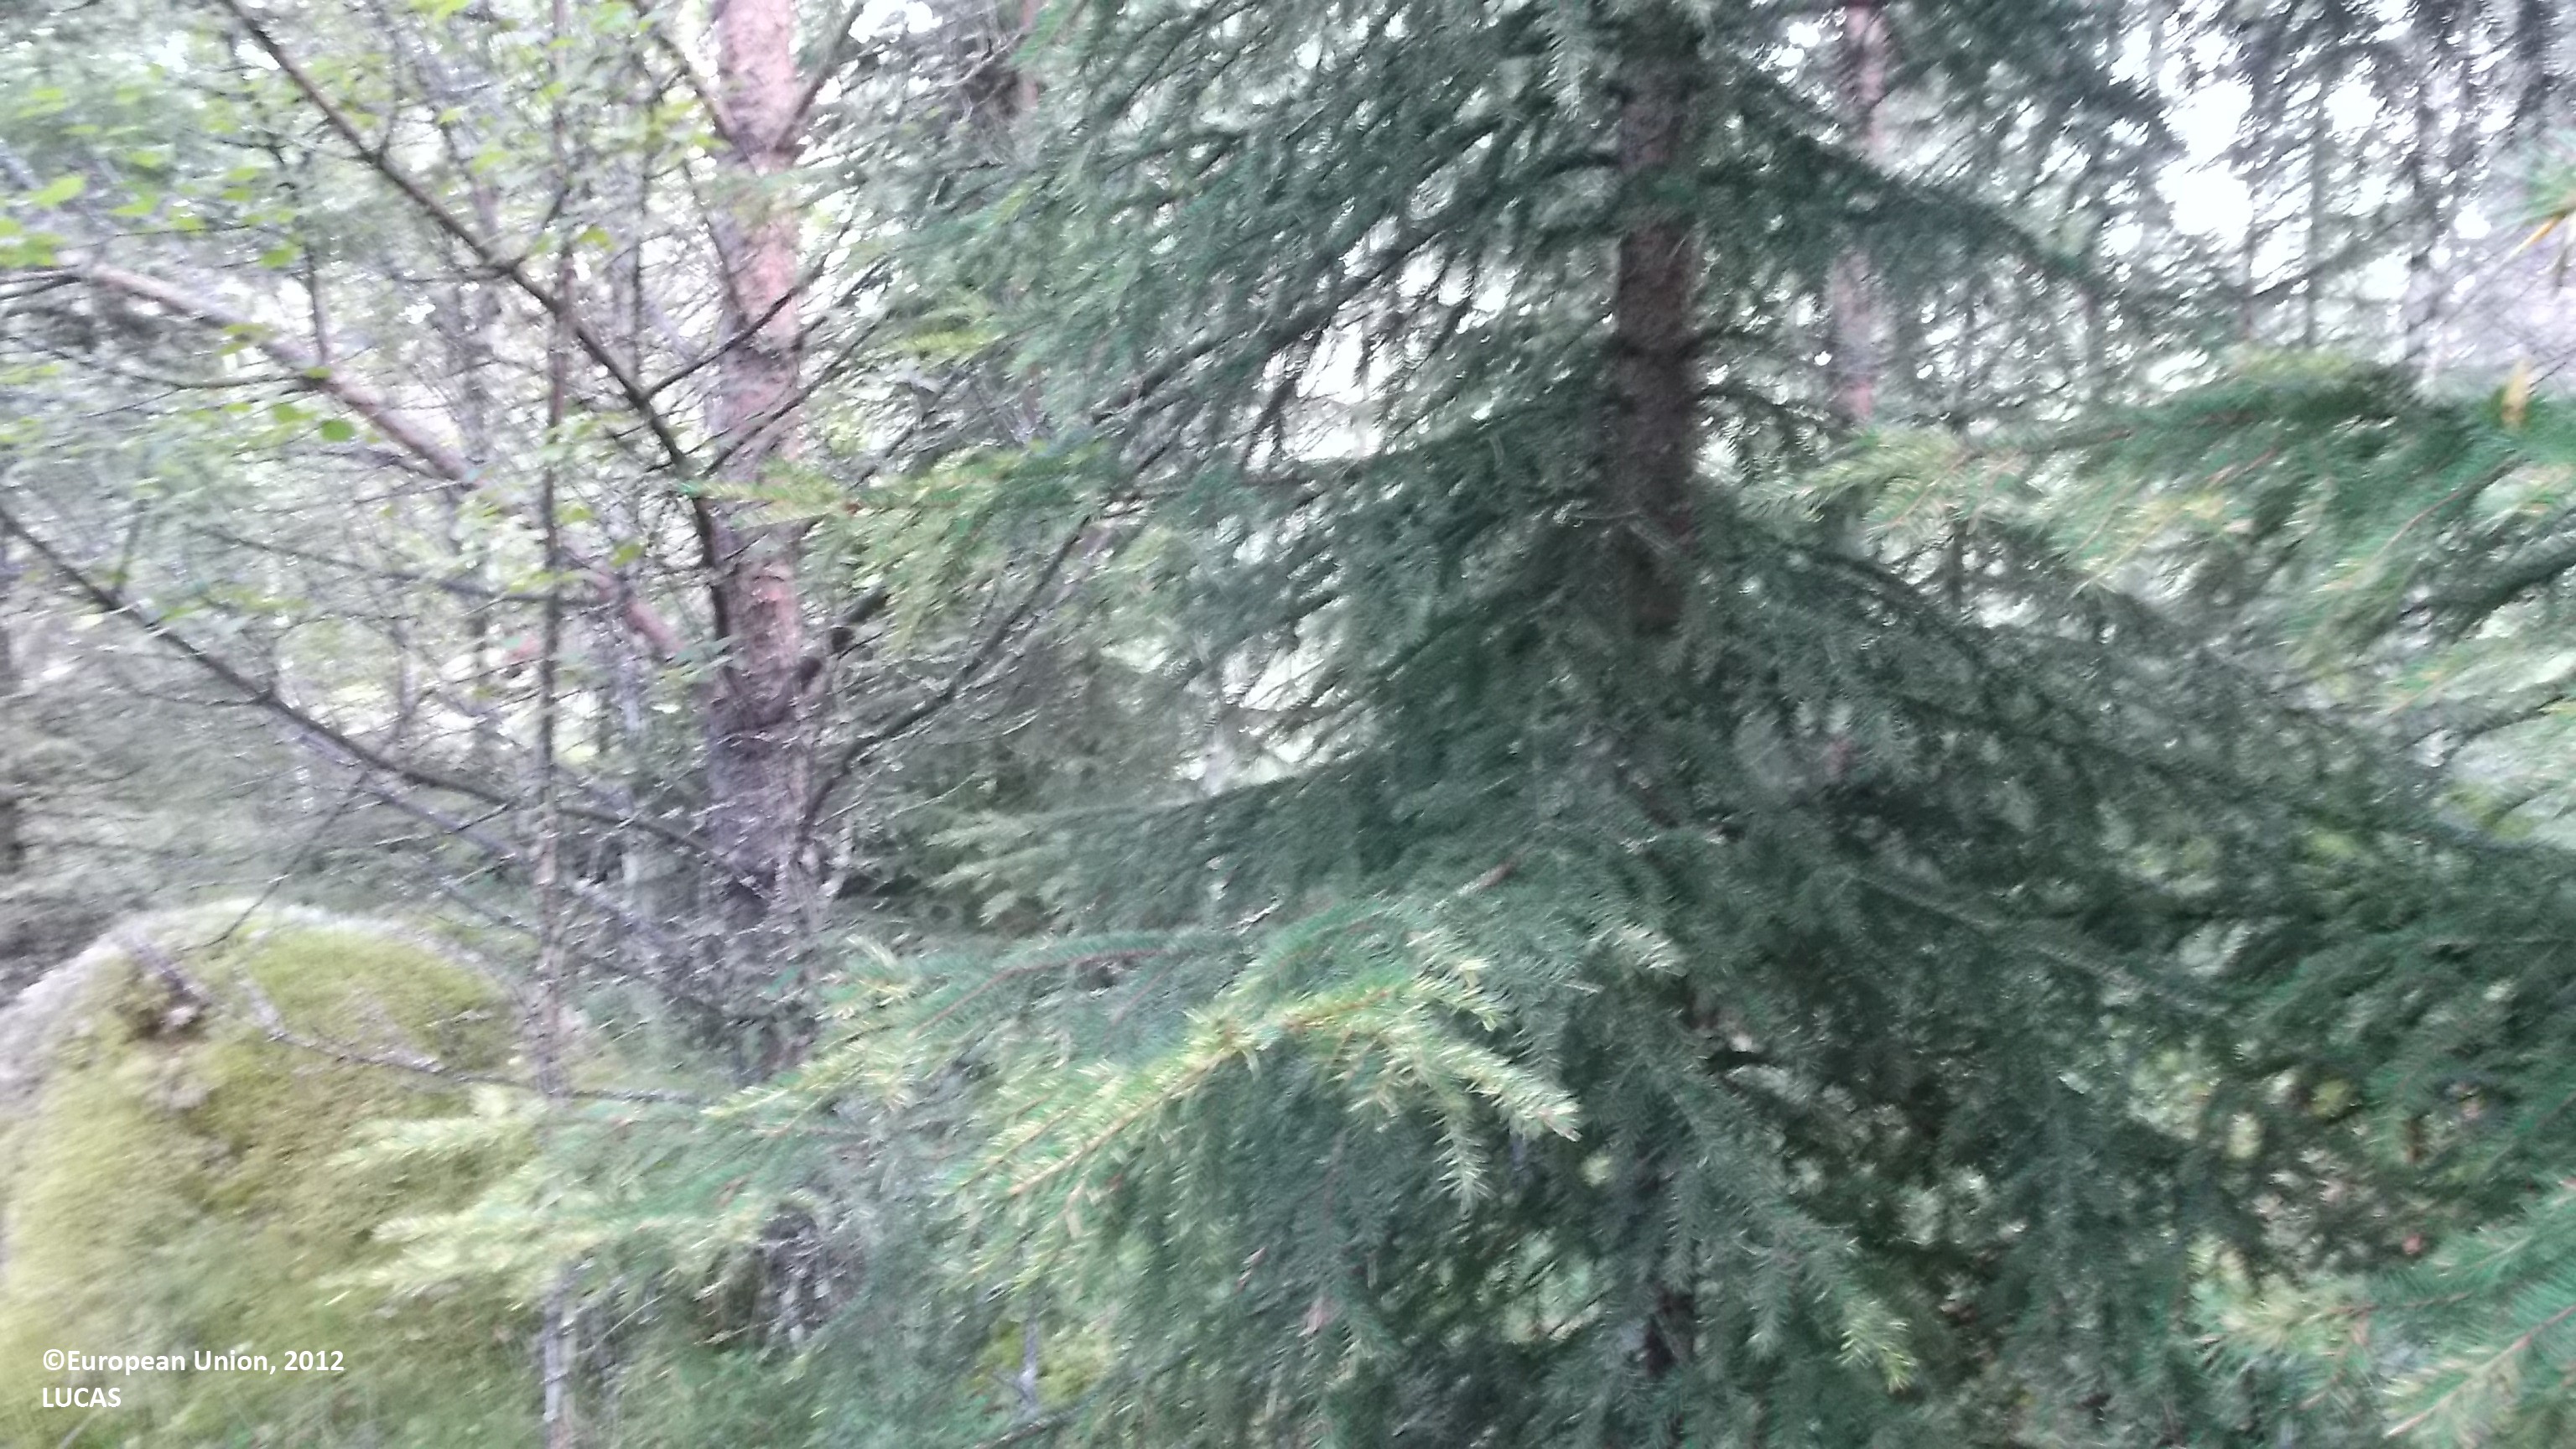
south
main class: Woodland
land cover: Pine dominated mixed woodland
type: boreal forest
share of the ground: 50 - 75 %
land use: Forestry
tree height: > 5 m
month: August
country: FI
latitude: 63.9640
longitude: 23.7217
